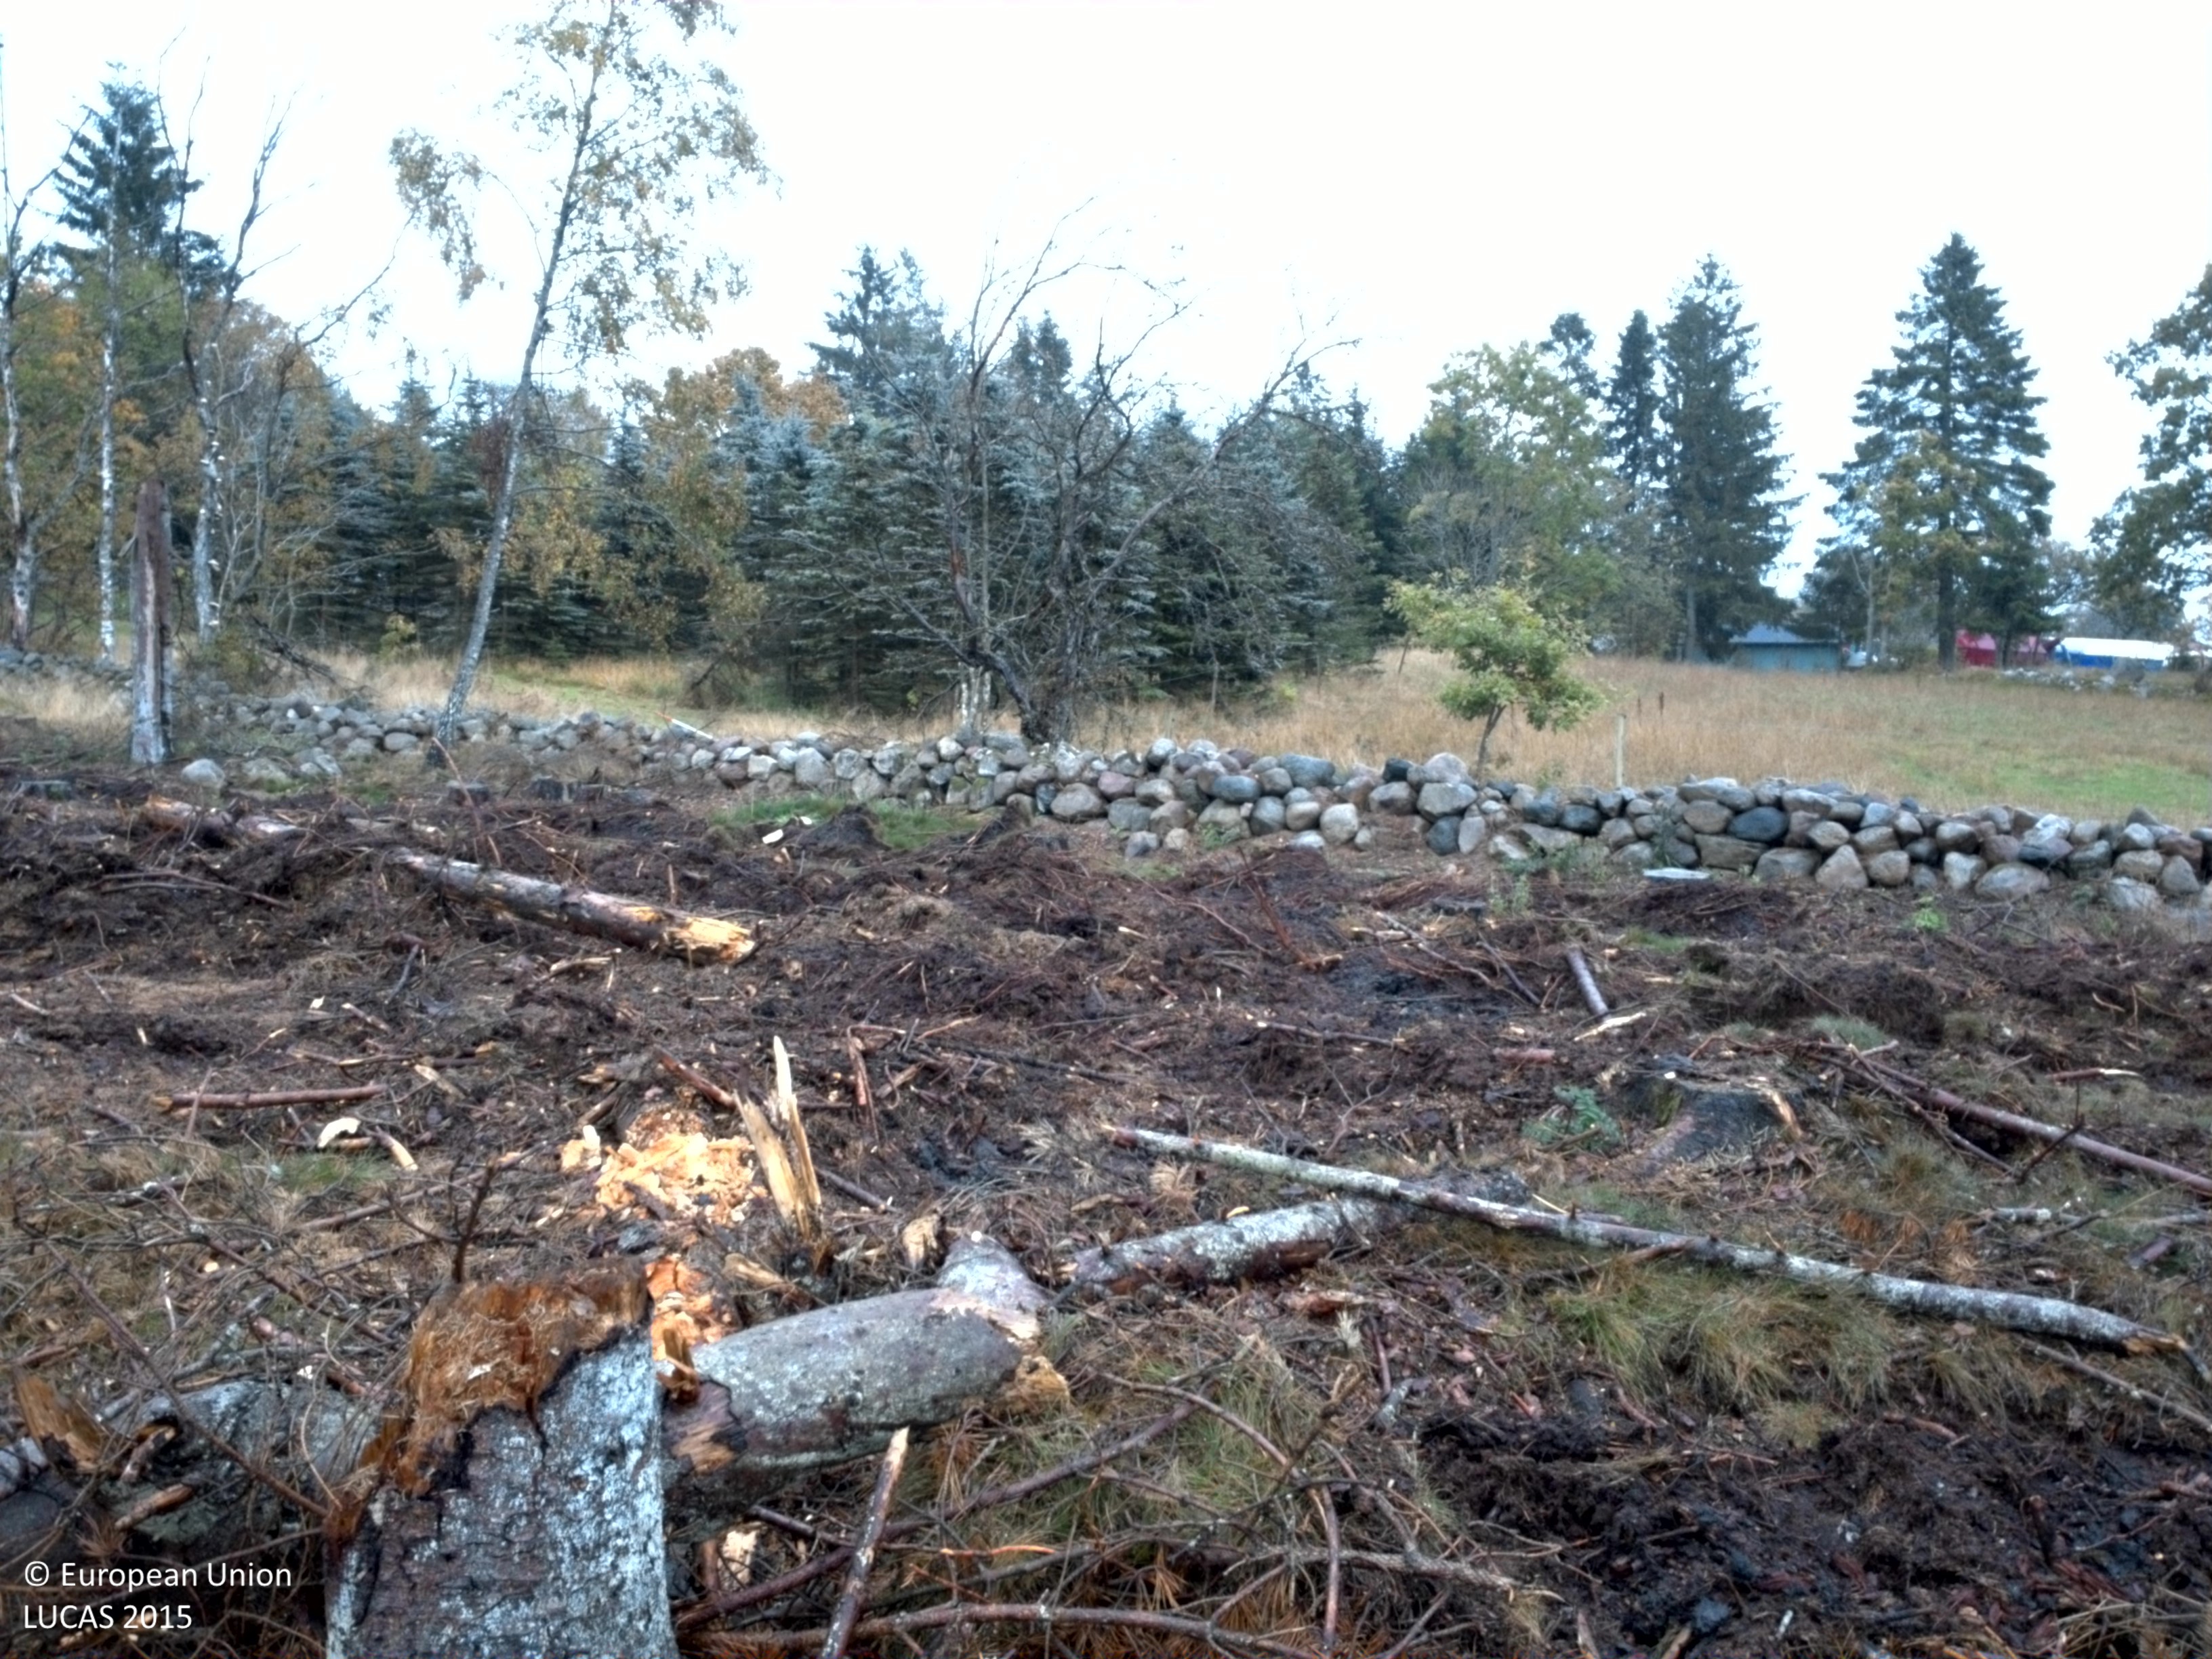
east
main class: Grassland
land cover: Grassland without tree/shrub cover
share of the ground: 10 - 25 %
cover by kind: unconsolidated bare surface 40 %, herbaceous plants 15 %
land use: Forestry
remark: Clear cut
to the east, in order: Grassland without tree/shrub cover; Dry stone walls; Single bushes/trees; Grassland without tree/shrub cover; Spruce dominated coniferous woodland; Single bushes/trees; Dry stone walls; Grassland with sparse tree/shrub cover; Broadleaved woodland; Managed hedges; Grassland without tree/shrub cover; Managed hedges; Paved roads, cycling and walking lanes; Artificial constructions in urban areas; Paved roads, cycling and walking lanes; Maize
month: October
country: SE
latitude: 55.7296
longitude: 13.9951
